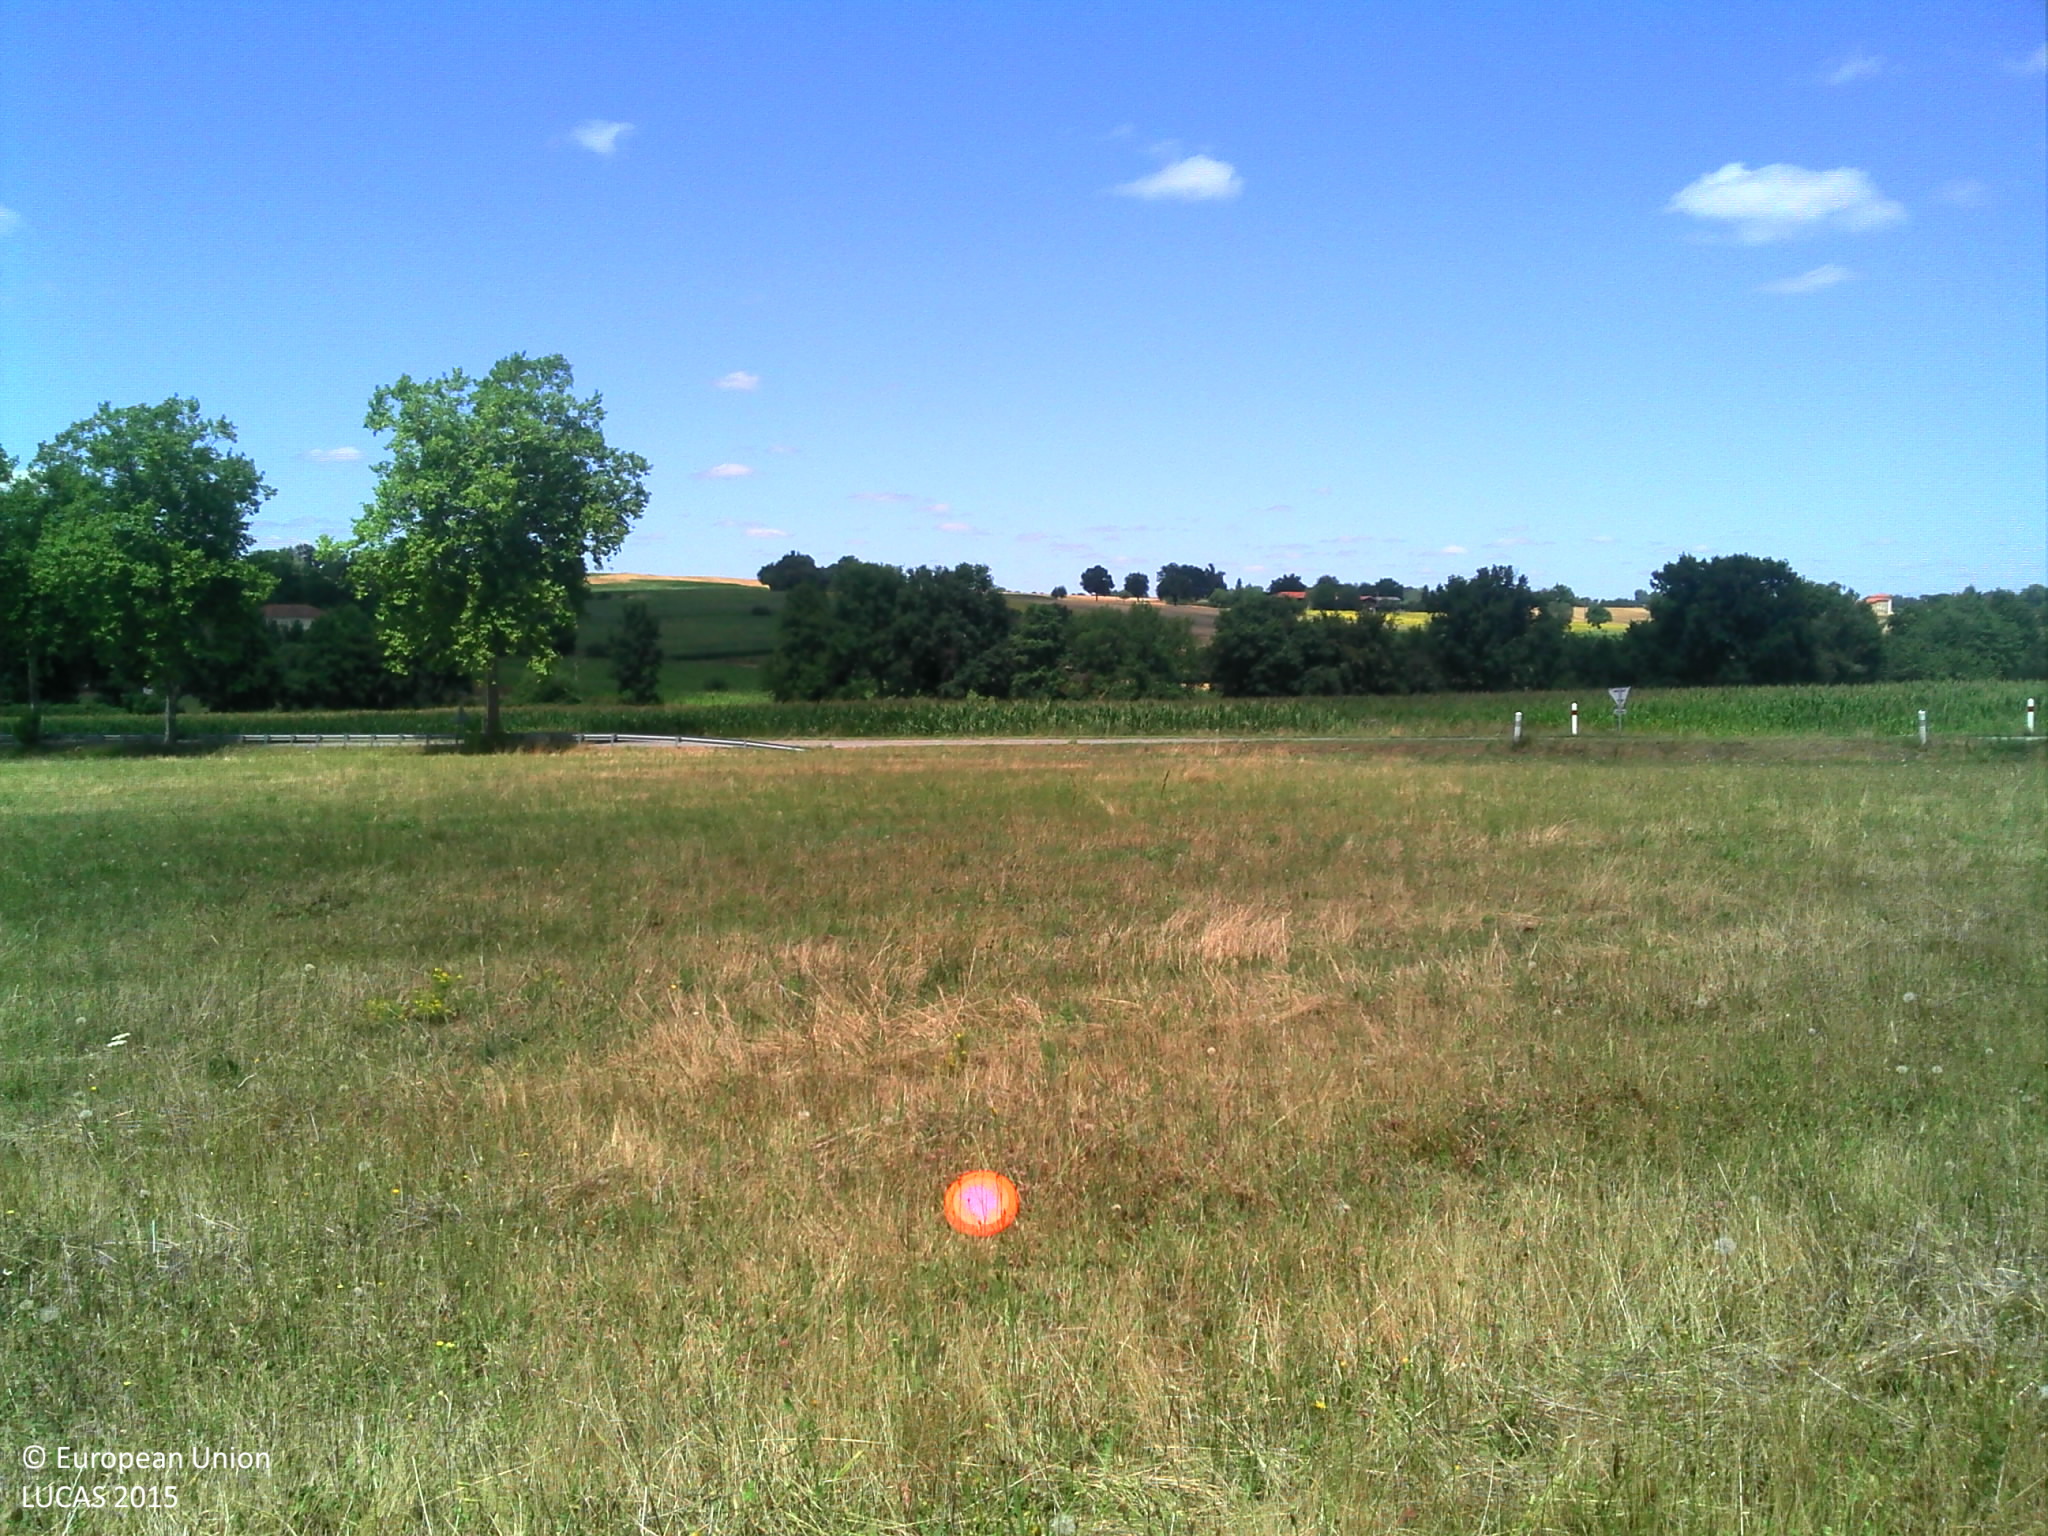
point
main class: Grassland
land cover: Grassland without tree/shrub cover
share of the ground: > 75 %
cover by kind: herbaceous plants 100 %
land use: Agriculture (excluding fallow land and kitchen gardens)
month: July
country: FR
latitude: 43.2471
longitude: 0.7517
